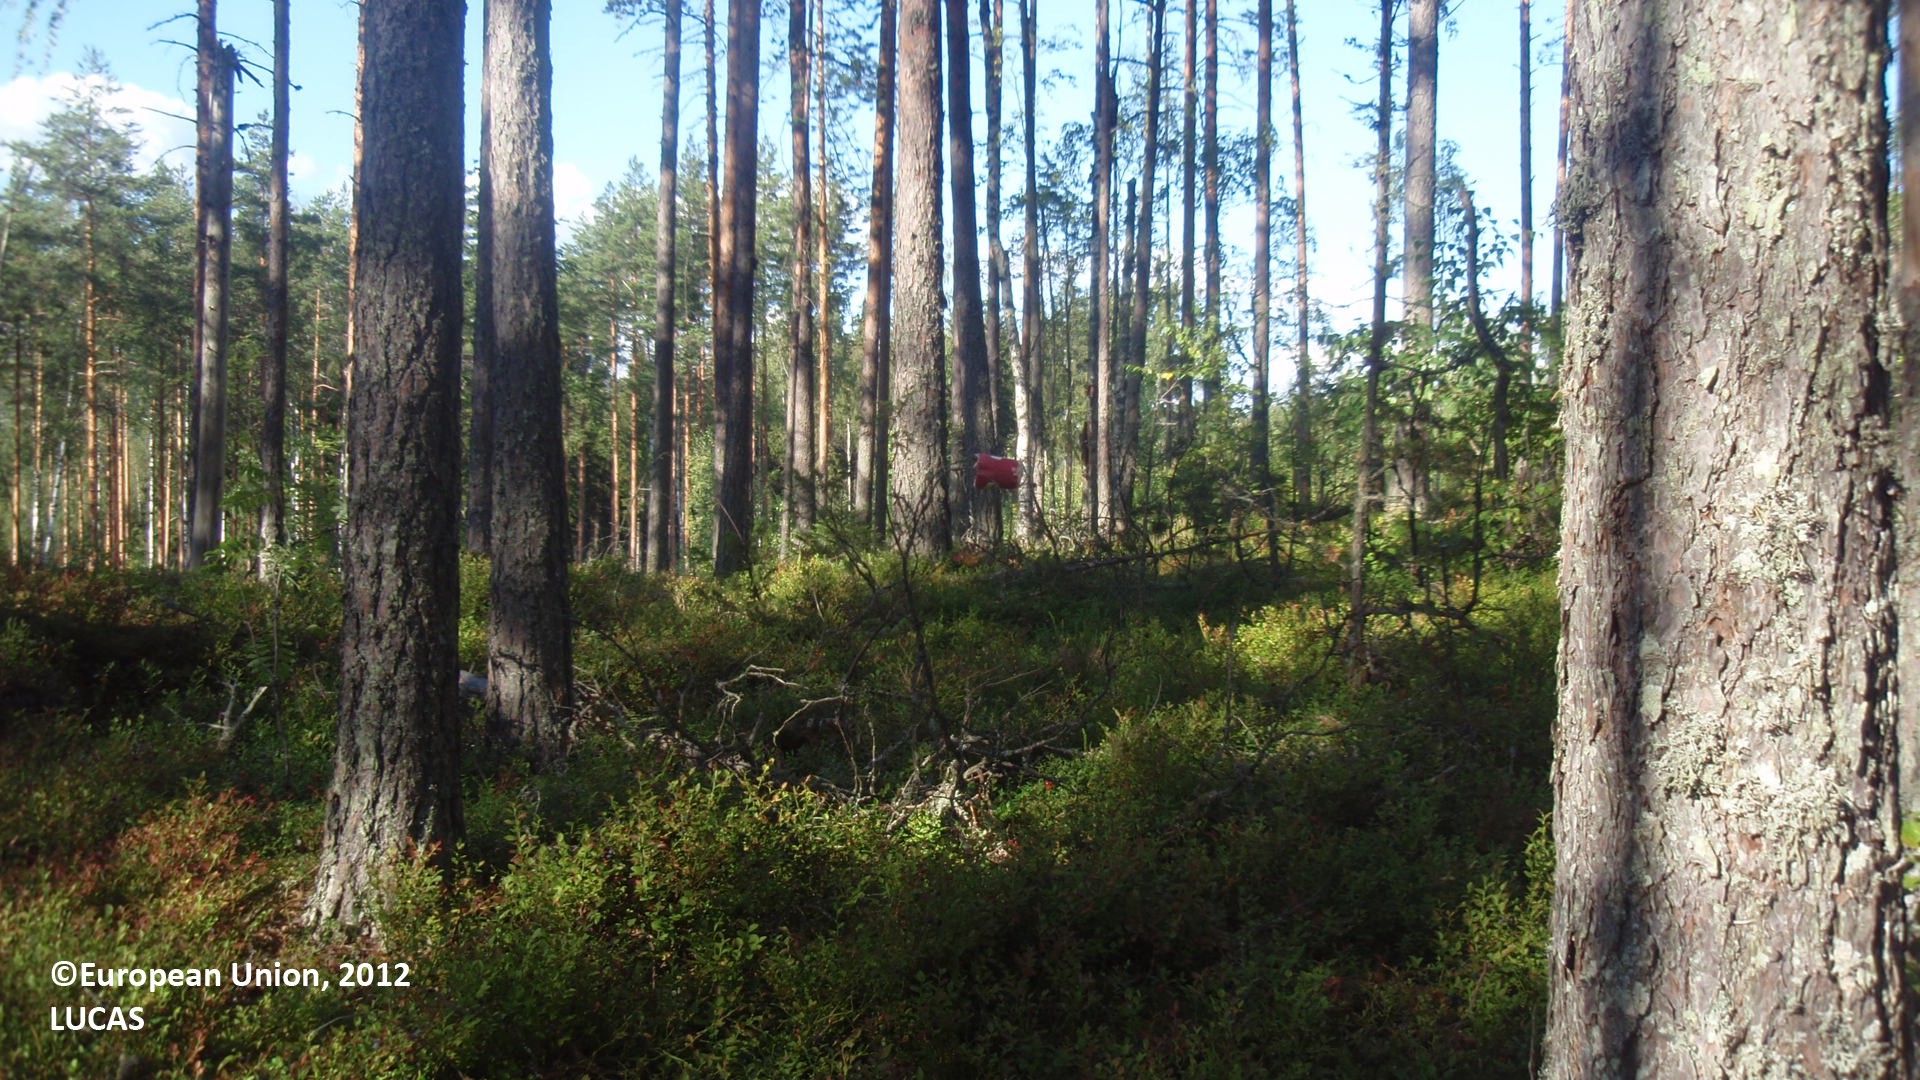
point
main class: Woodland
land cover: Pine dominated coniferous woodland
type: boreal forest
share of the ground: 50 - 75 %
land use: Forestry
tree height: > 5 m
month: August
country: FI
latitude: 61.5578
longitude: 27.7846
